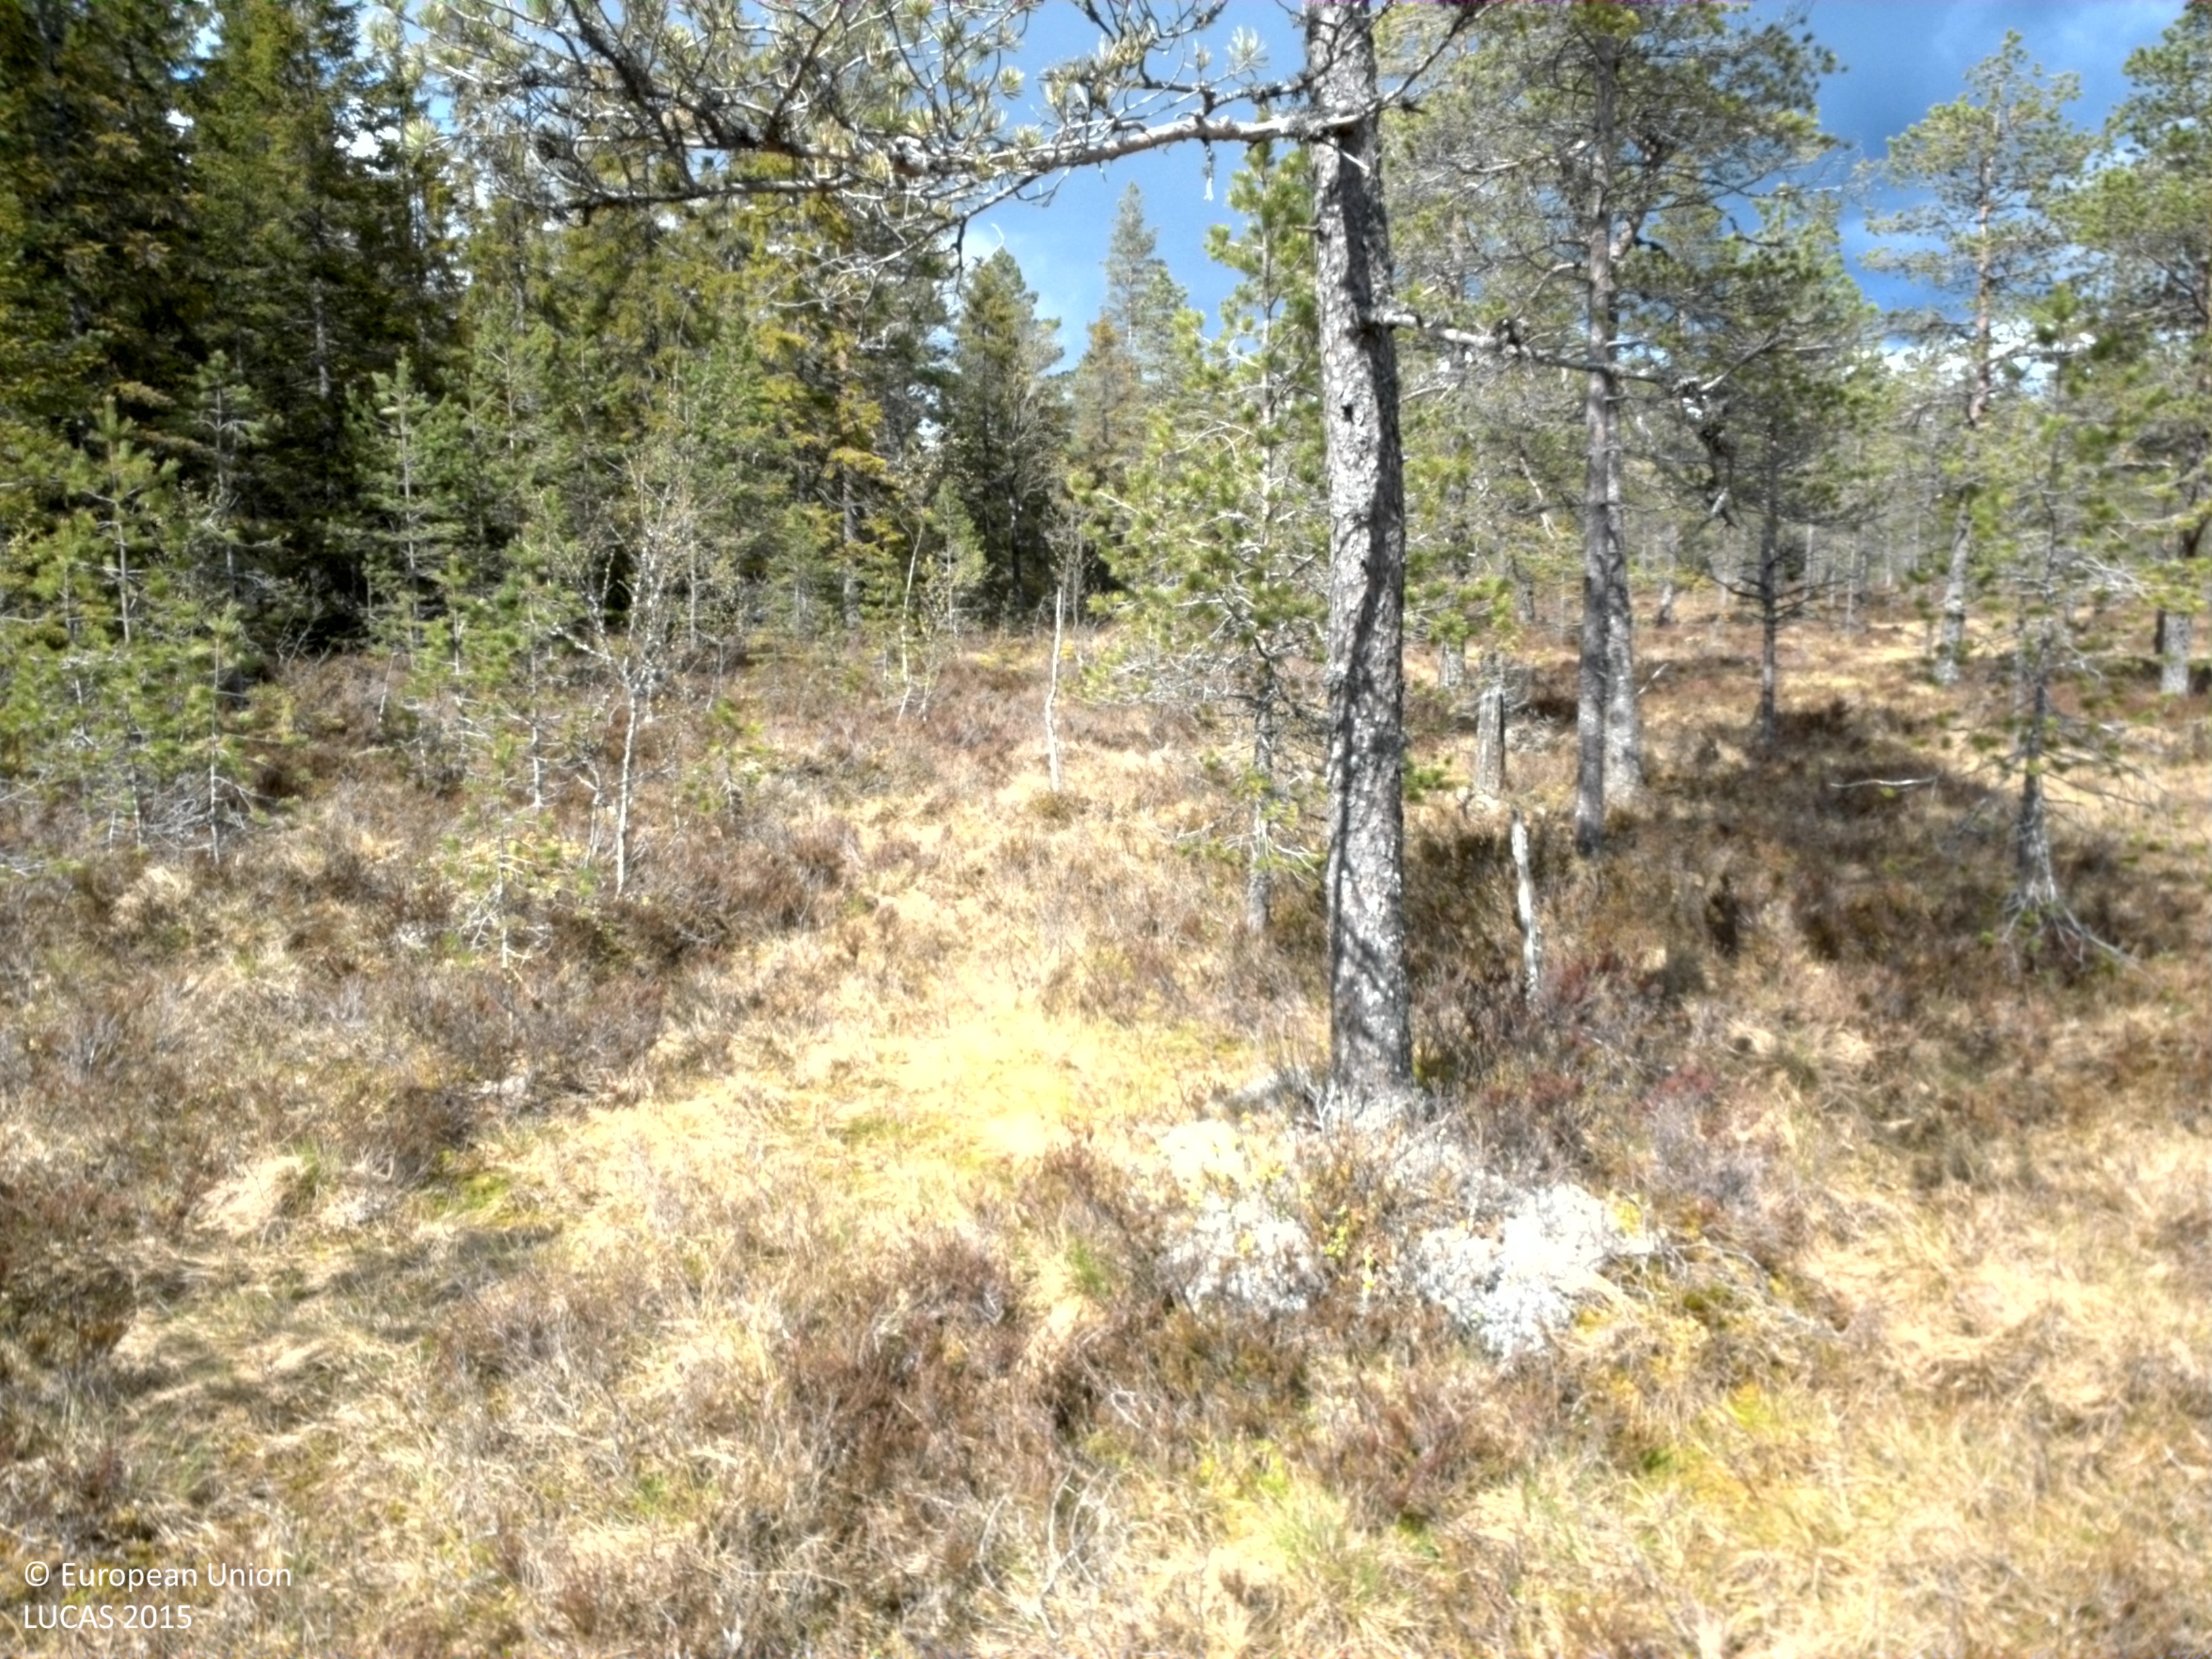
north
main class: Woodland
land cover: Pine dominated coniferous woodland
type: mire and swamp forests
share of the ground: 10 - 25 %
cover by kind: herbaceous plants 45 %, shrubs 40 %, coniferous forest trees 15 %
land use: Semi-natural and natural areas not in use
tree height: > 5 m
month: May
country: SE
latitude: 60.4059
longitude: 13.5659
